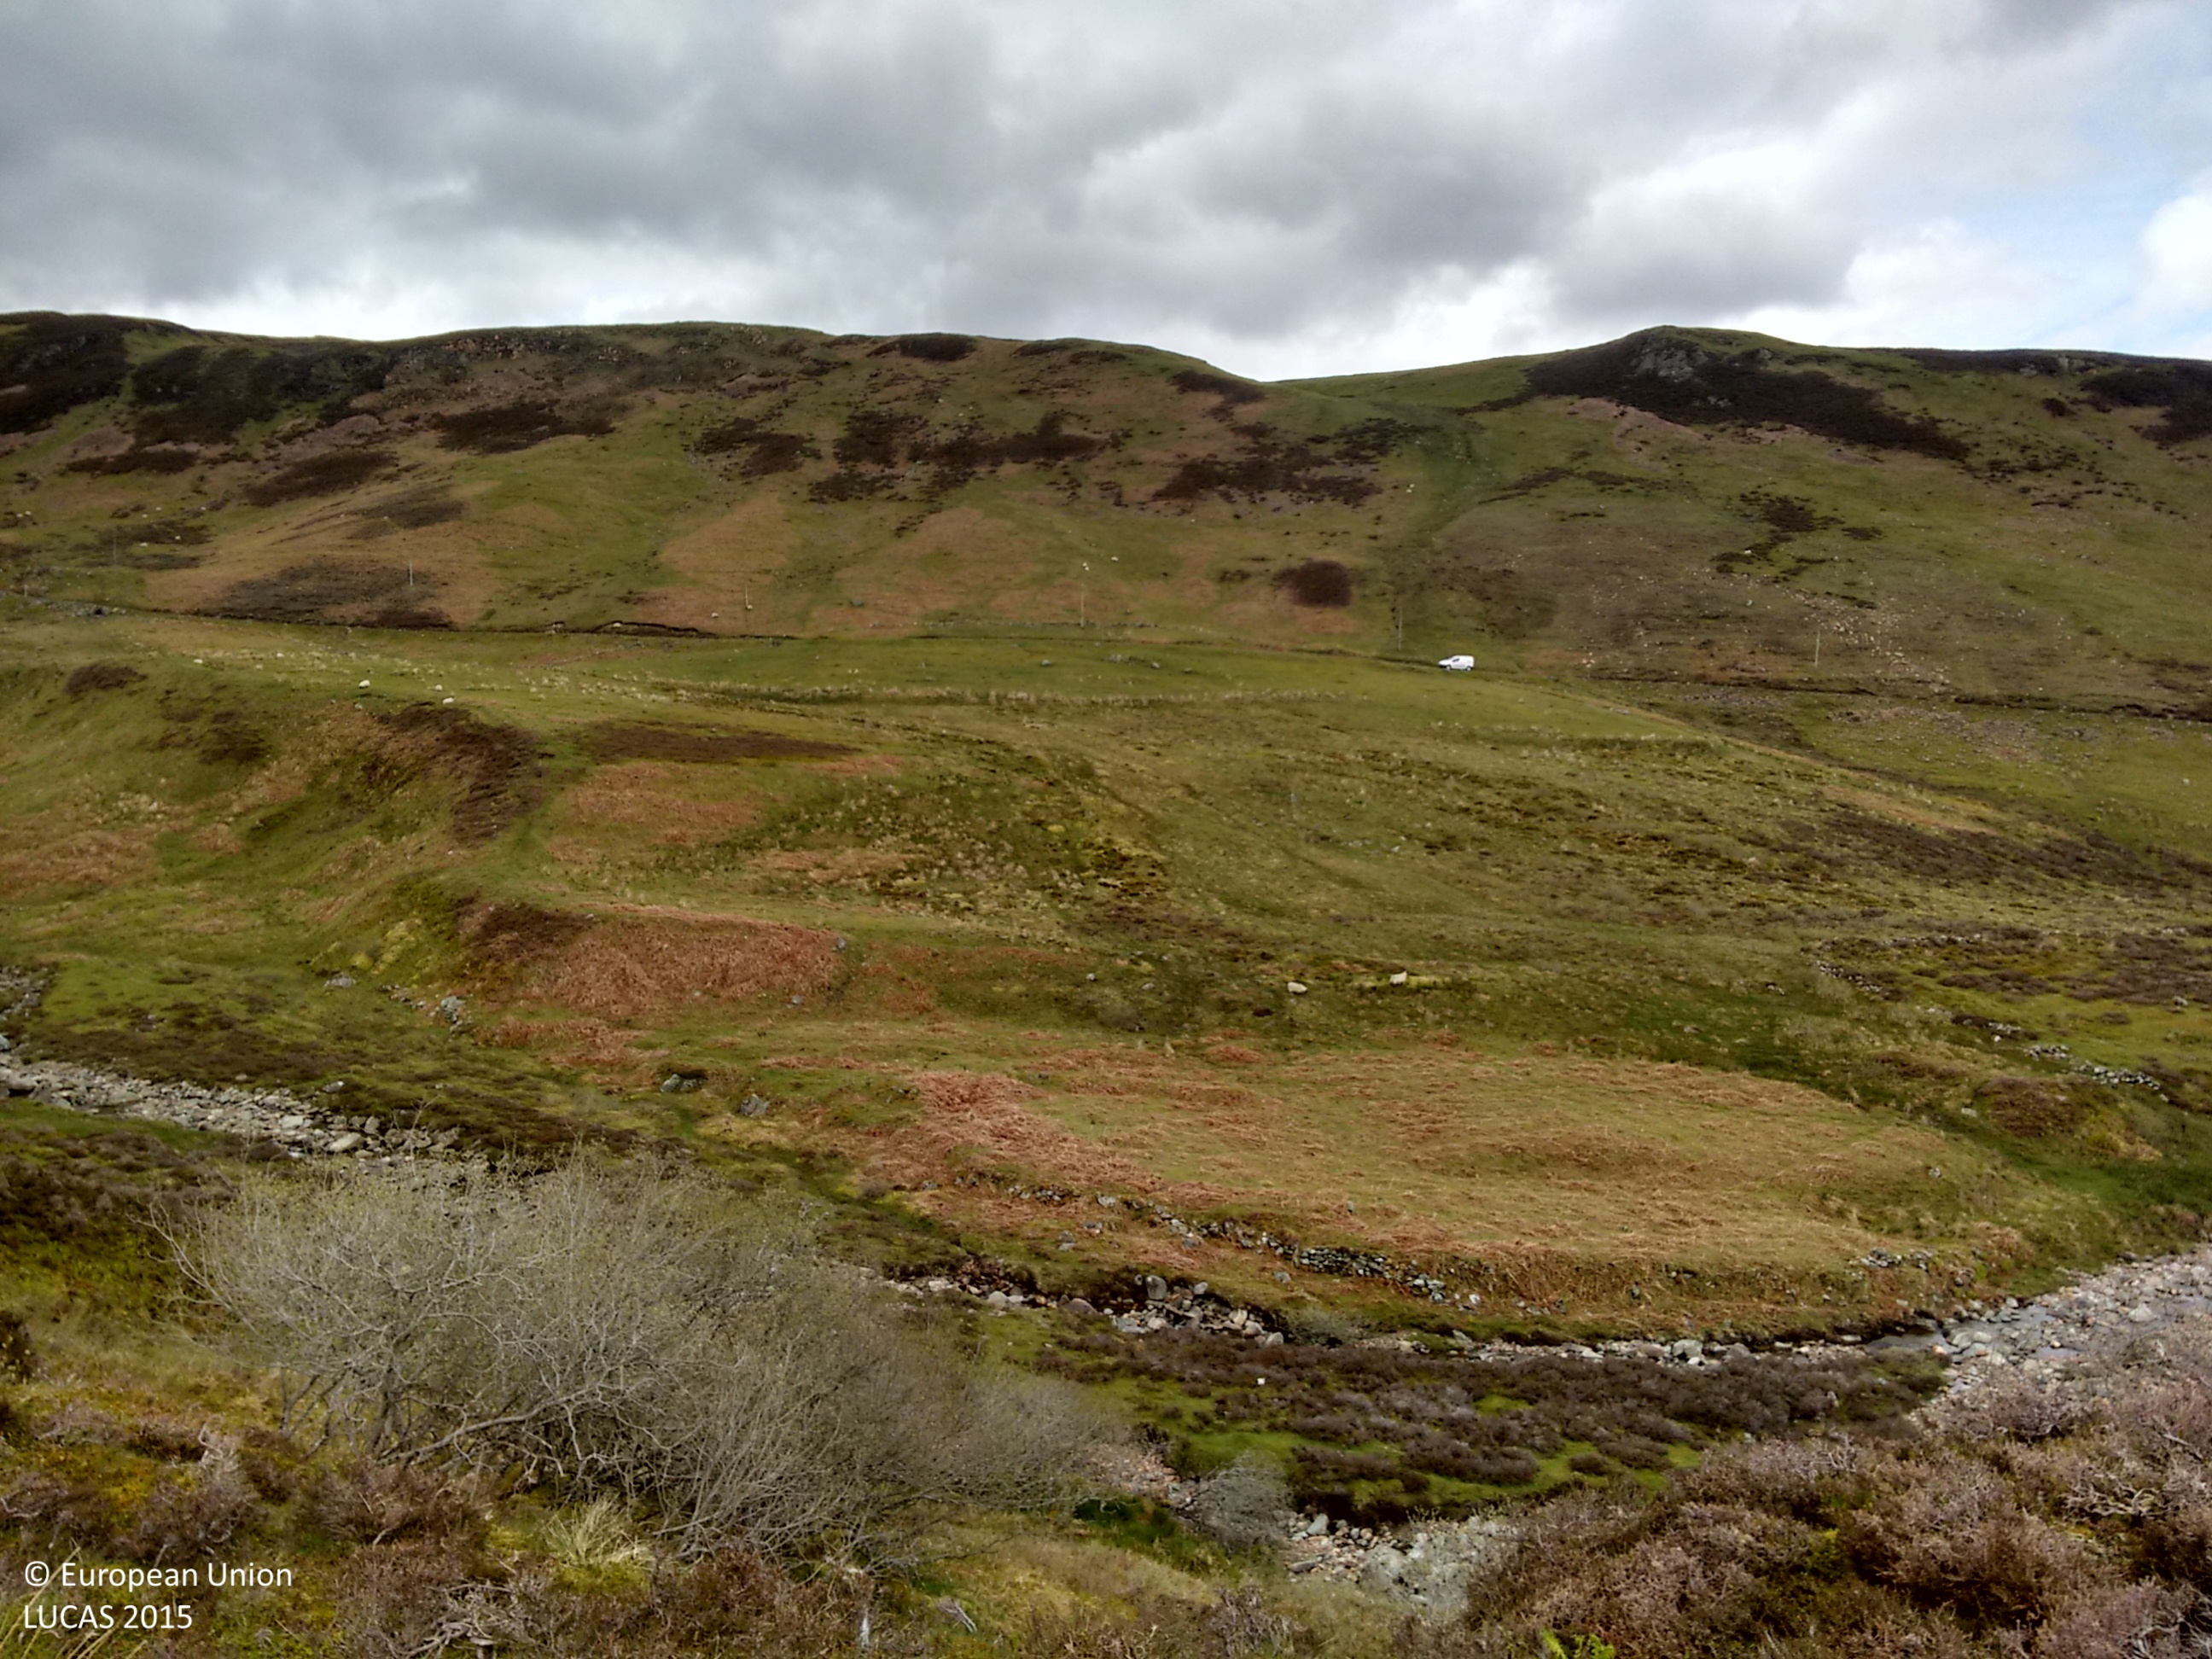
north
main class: Shrubland
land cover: Shrubland without tree cover
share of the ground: > 75 %
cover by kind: shrubs 70 %, lichens and mosses 25 %, herbaceous plants 5 %
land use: Agriculture (excluding fallow land and kitchen gardens)
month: June
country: GB
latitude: 56.4300
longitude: -4.0811
